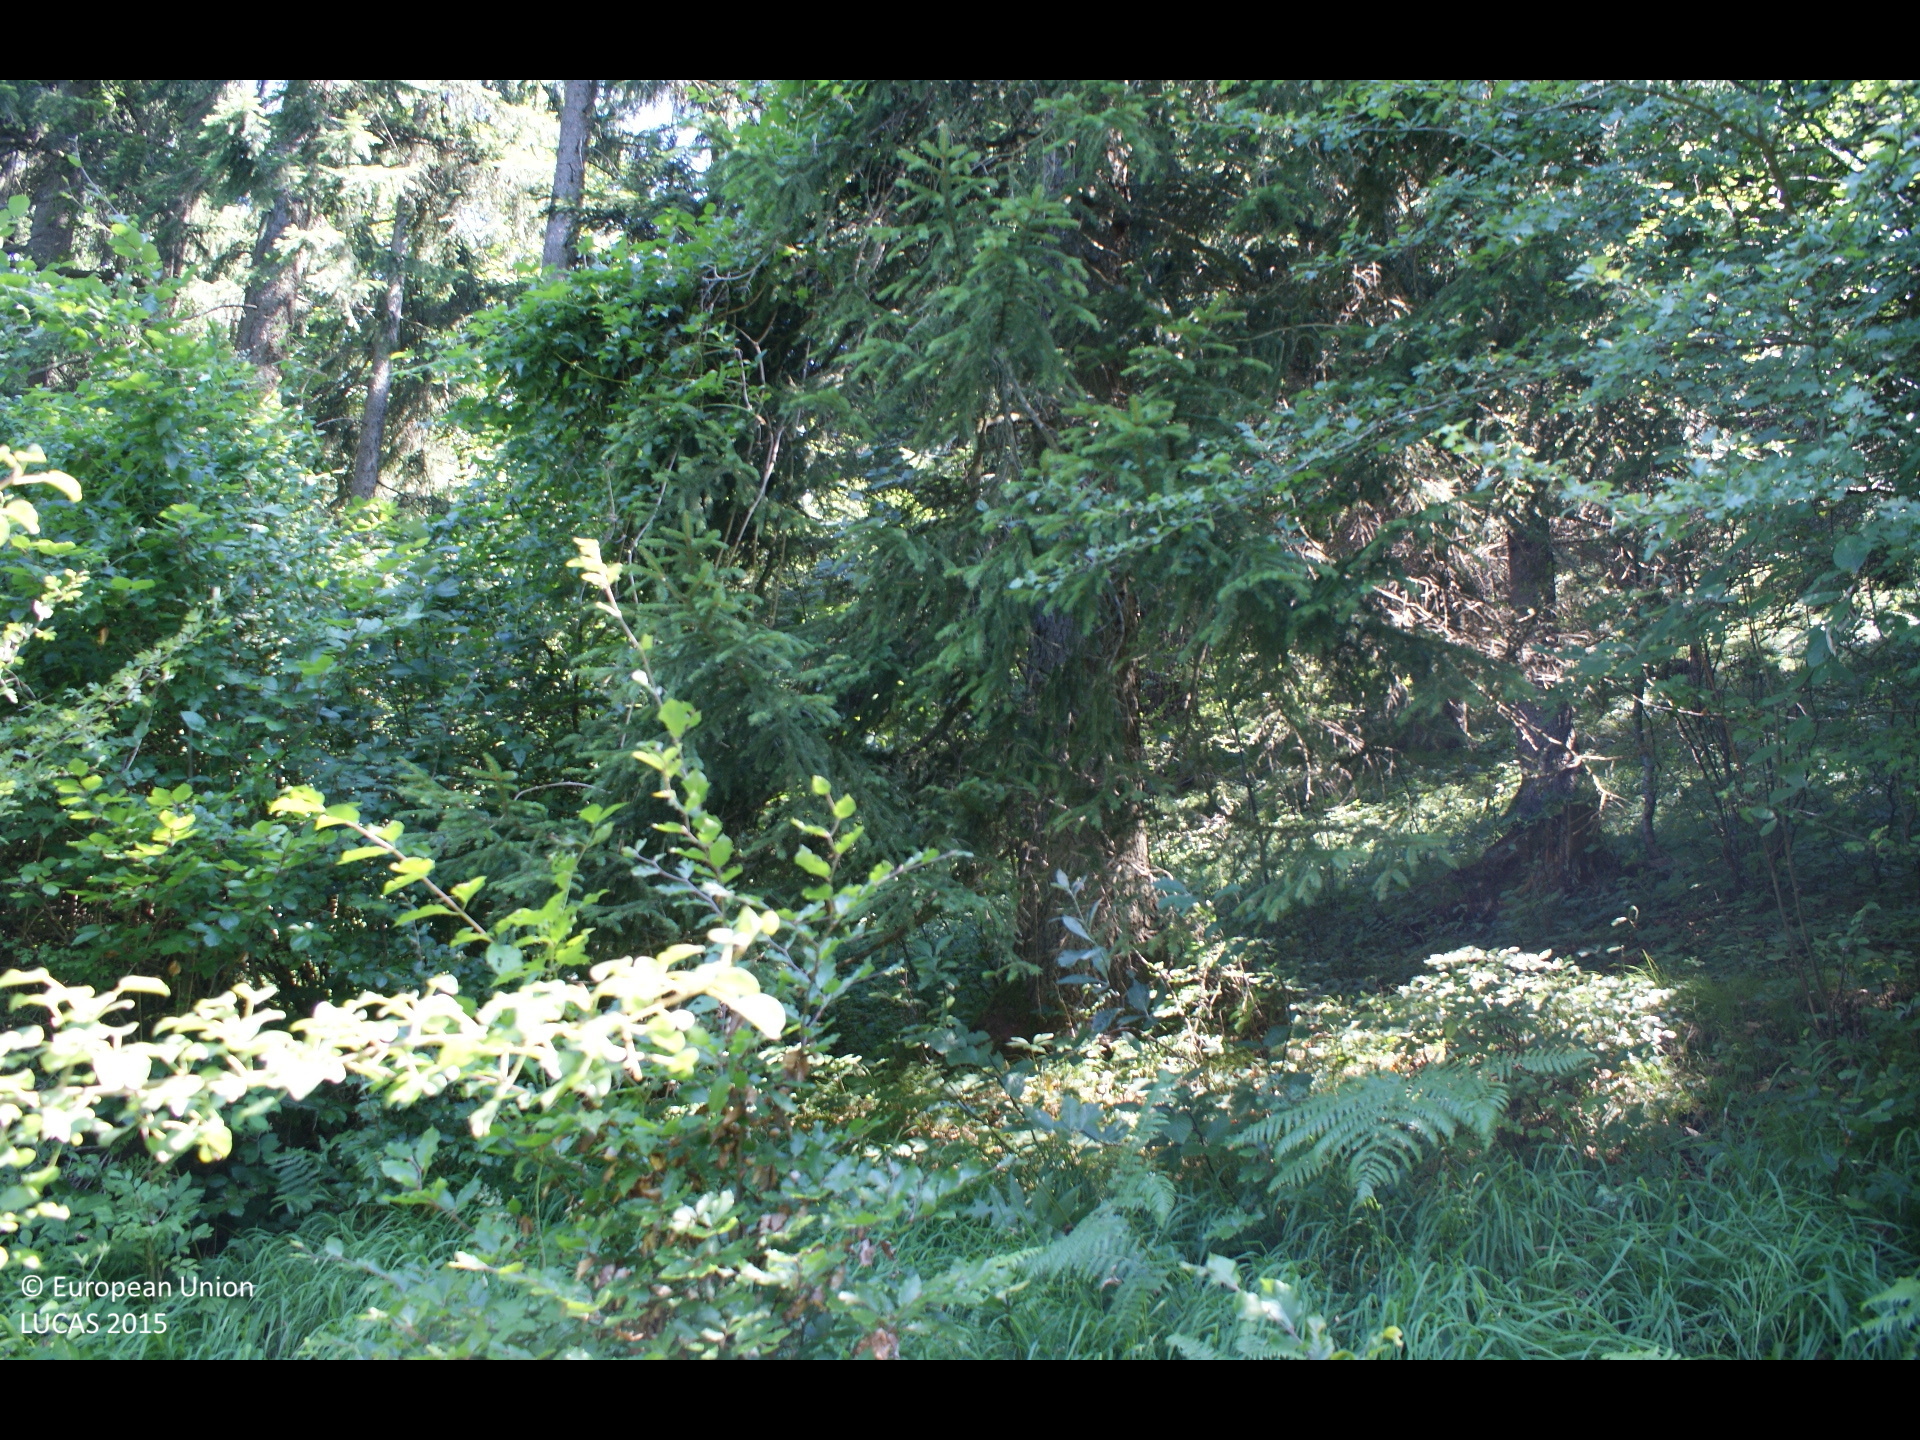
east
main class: Woodland
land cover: Broadleaved woodland
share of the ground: > 75 %
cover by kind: shrubs 40 %, herbaceous plants 30 %, broadleaved forest trees 25 %, coniferous forest trees 5 %
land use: Forestry
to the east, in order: Broadleaved woodland; Spruce dominated coniferous woodland
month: July
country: AT
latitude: 47.9523
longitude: 15.2905
